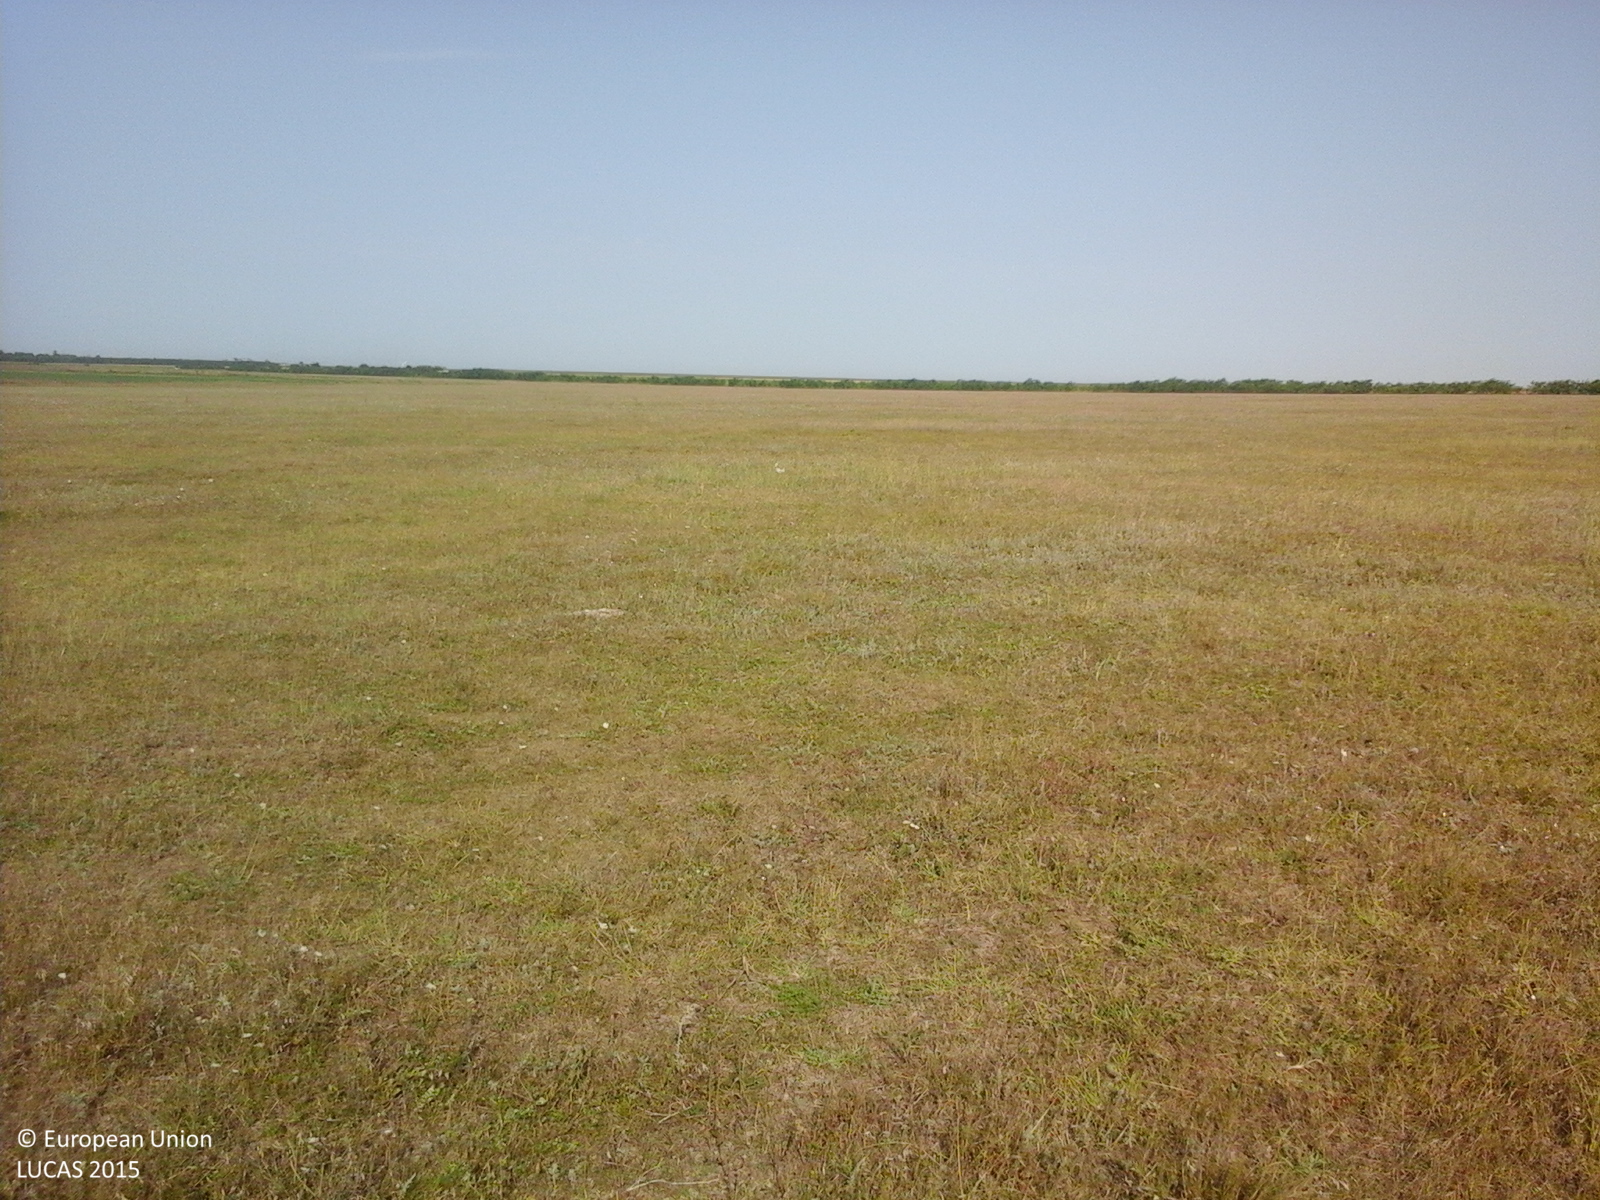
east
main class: Grassland
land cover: Grassland without tree/shrub cover
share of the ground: > 75 %
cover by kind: herbaceous plants 100 %
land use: Agriculture (excluding fallow land and kitchen gardens)
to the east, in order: Grassland without tree/shrub cover
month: August
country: RO
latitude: 44.0755
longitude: 28.3829
